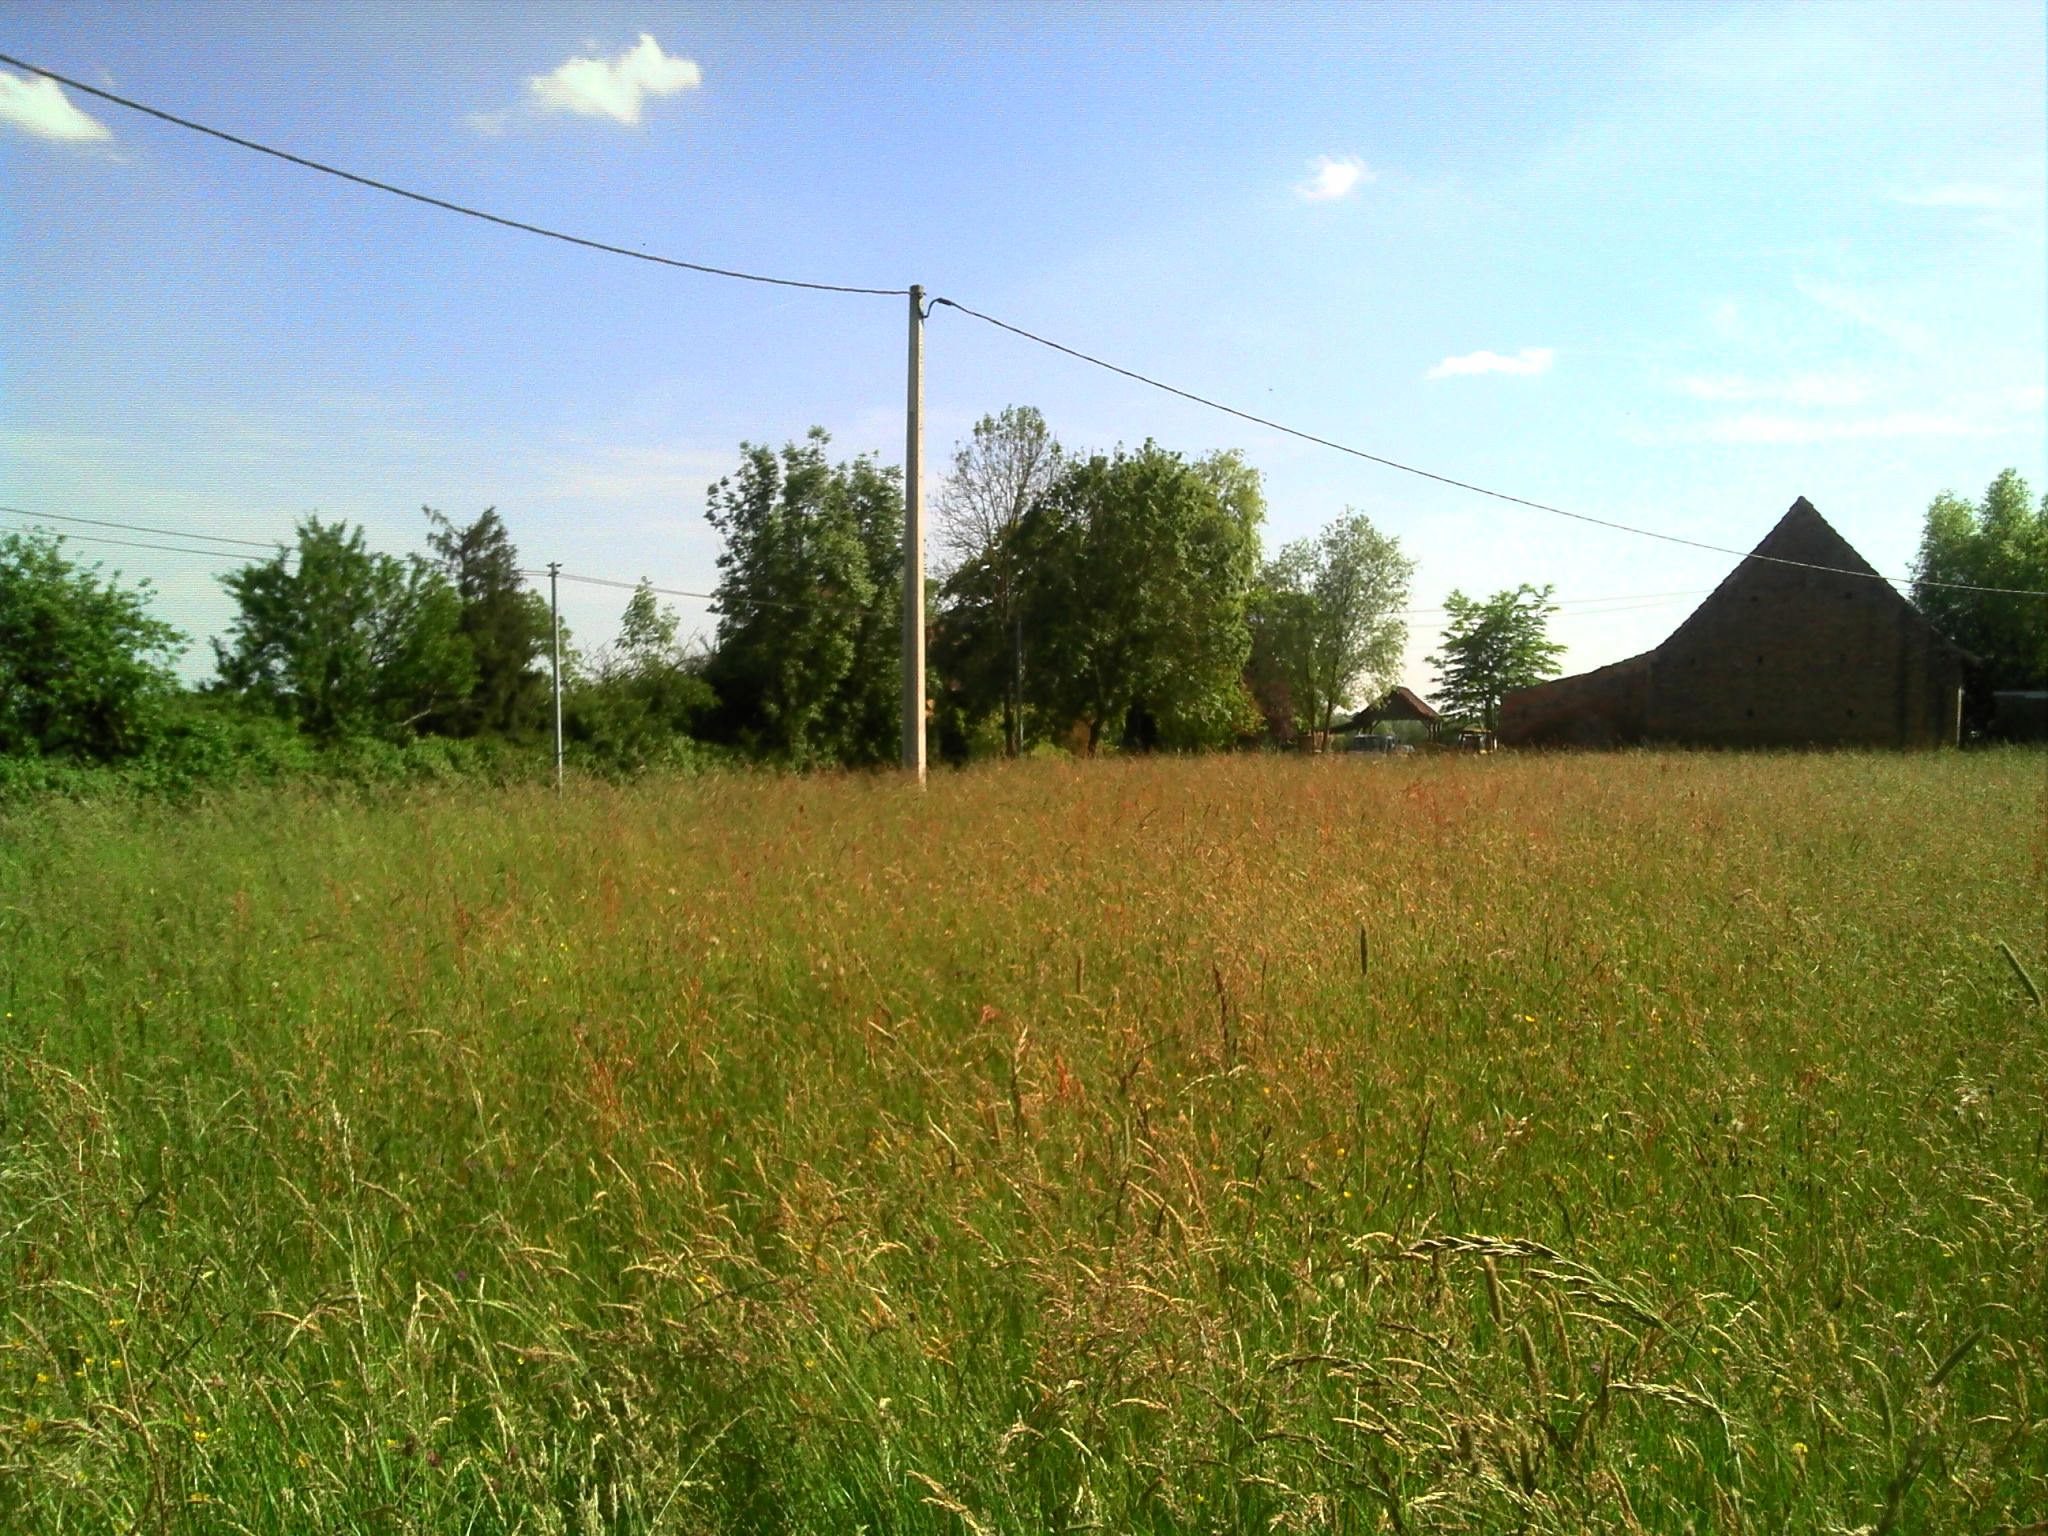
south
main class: Grassland
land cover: Grassland without tree/shrub cover
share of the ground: > 75 %
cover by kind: herbaceous plants 100 %
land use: Agriculture (excluding fallow land and kitchen gardens)
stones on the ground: < 10 %
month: May
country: FR
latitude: 46.6013
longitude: 5.1327
